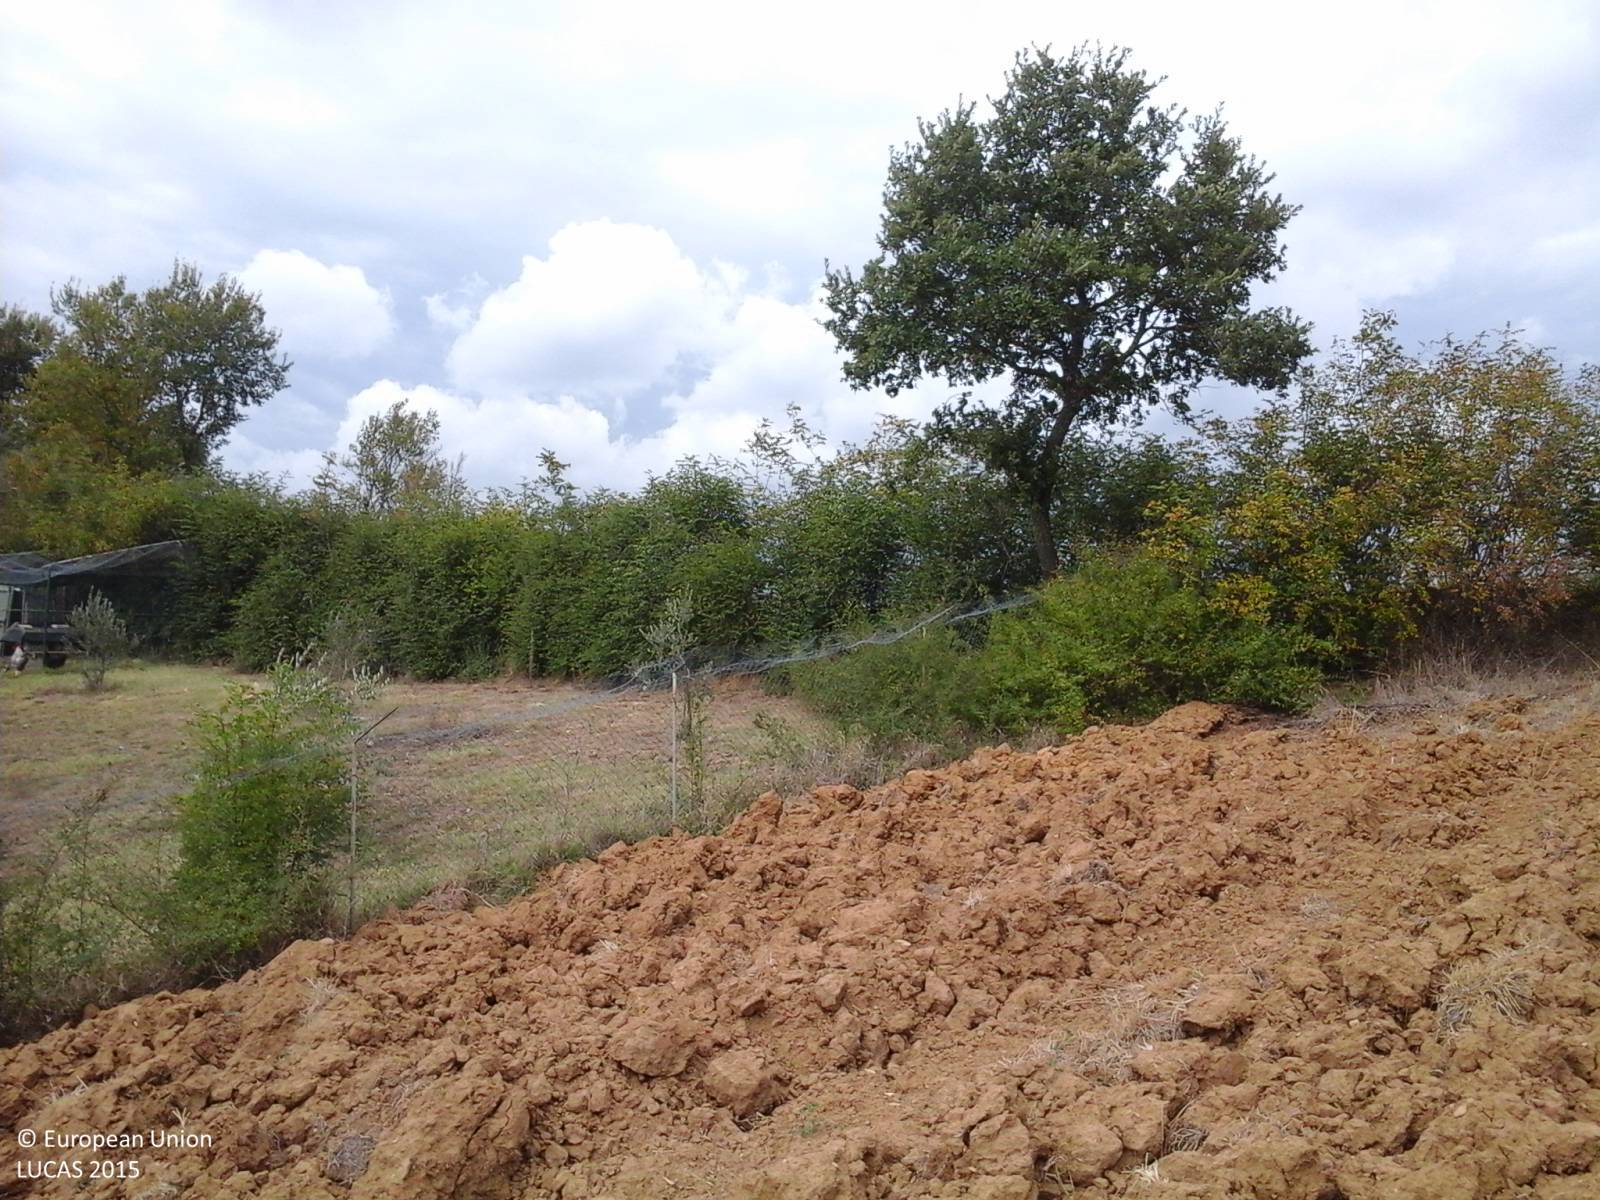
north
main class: Cropland
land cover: Lucerne
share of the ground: < 10 %
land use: Agriculture (excluding fallow land and kitchen gardens)
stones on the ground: 10 - 25 %
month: September
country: IT
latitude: 42.8834
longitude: 12.1849
